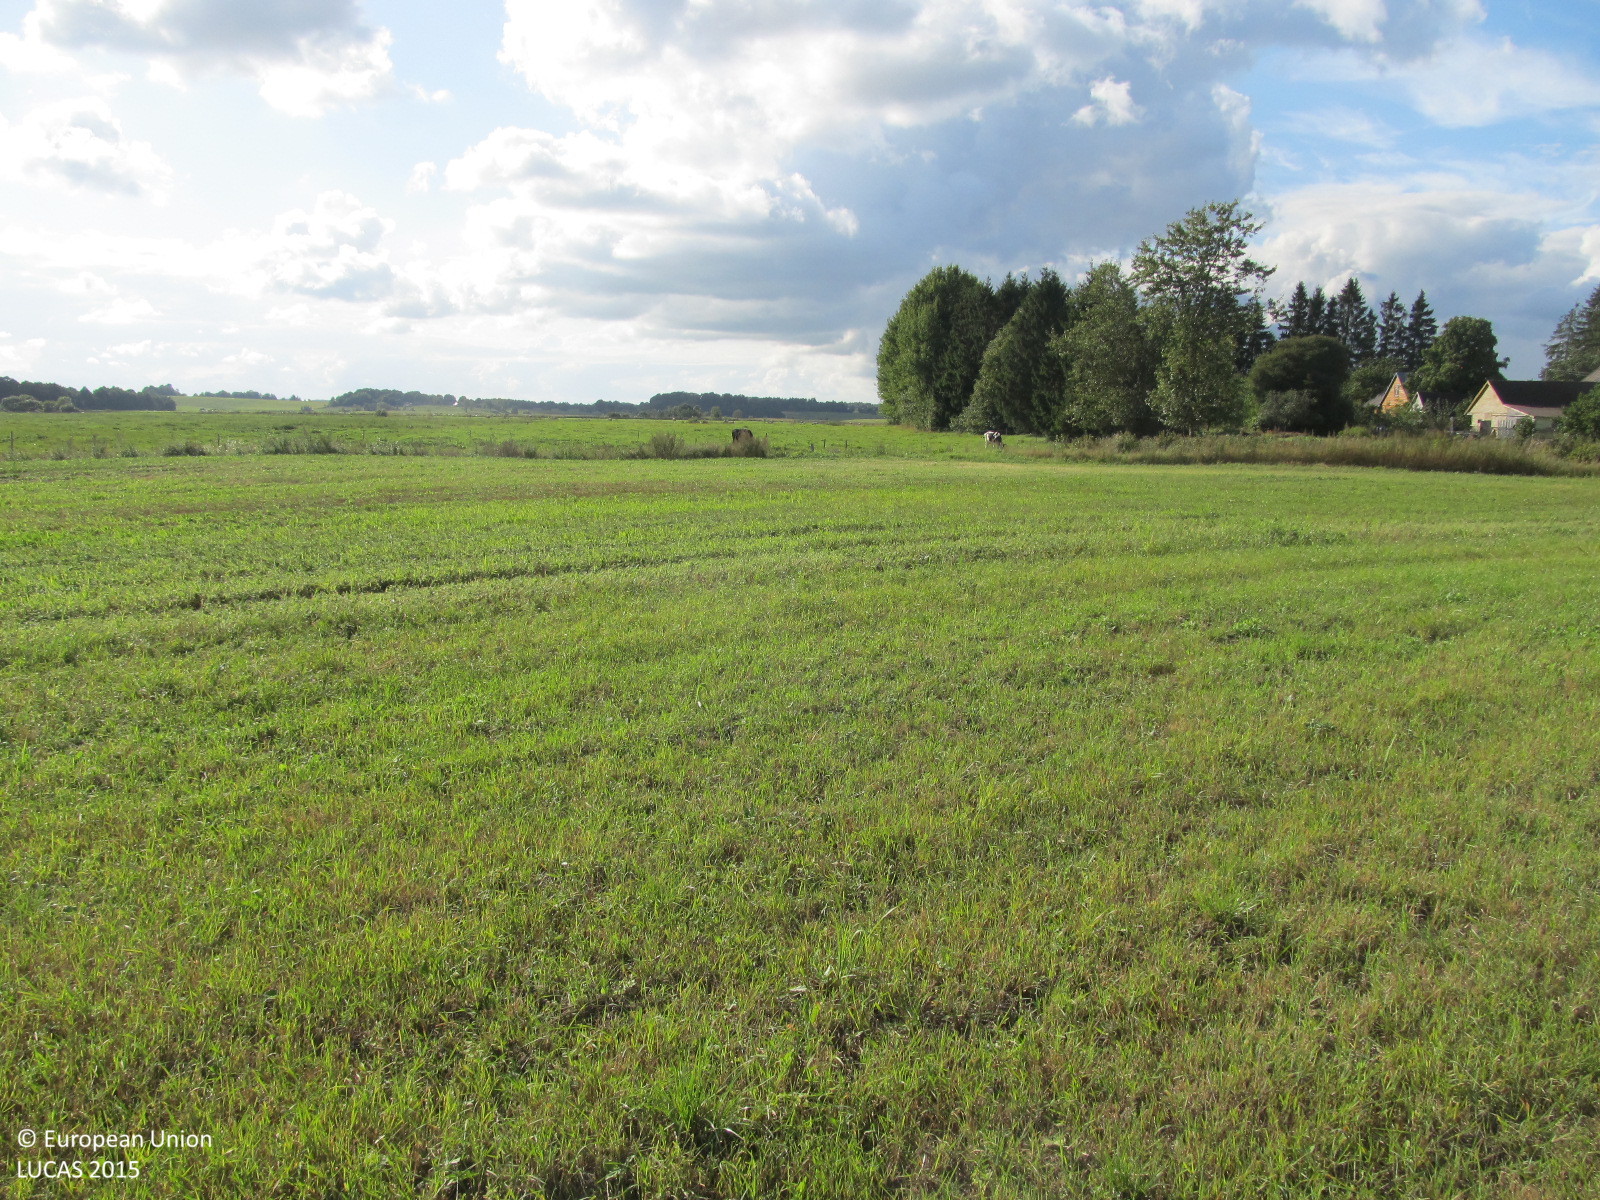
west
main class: Grassland
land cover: Grassland without tree/shrub cover
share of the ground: > 75 %
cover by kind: herbaceous plants 100 %
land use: Agriculture (excluding fallow land and kitchen gardens)
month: September
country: LT
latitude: 55.6690
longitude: 22.6388
